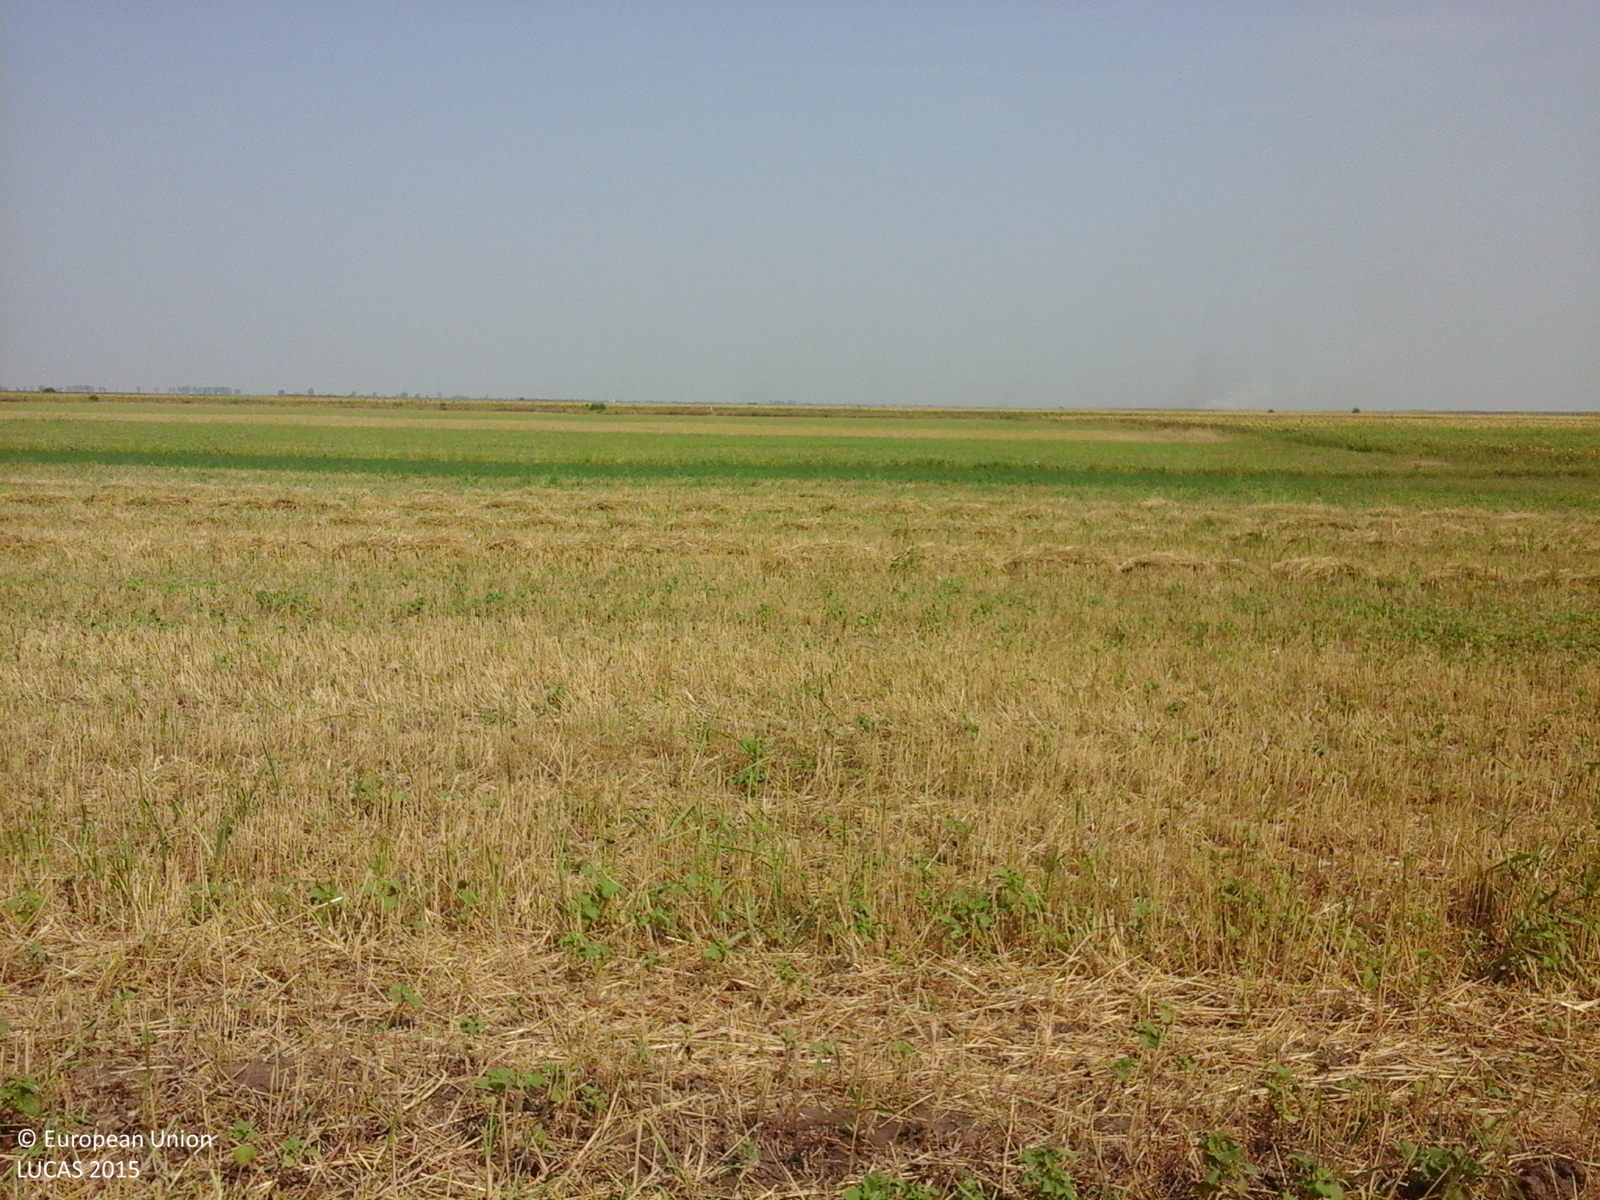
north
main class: Cropland
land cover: Common wheat
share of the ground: > 75 %
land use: Agriculture (excluding fallow land and kitchen gardens)
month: August
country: RO
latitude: 43.8833
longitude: 23.2247
